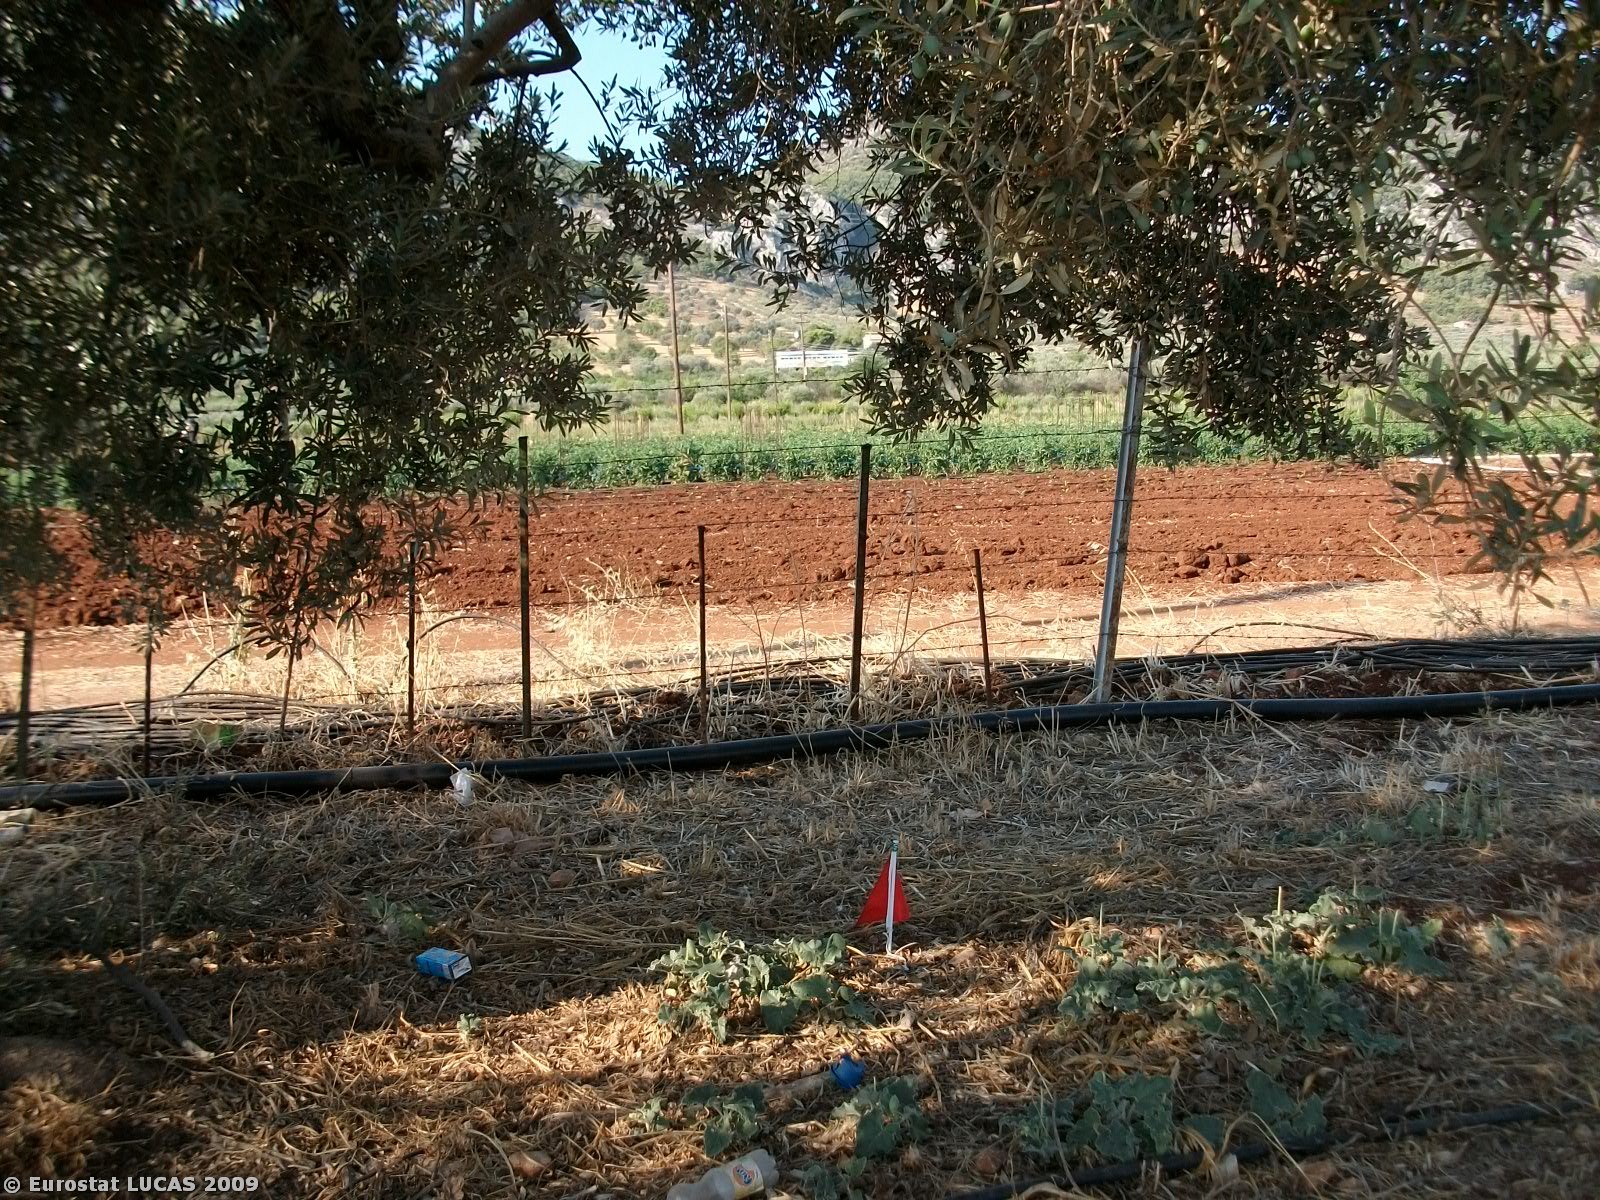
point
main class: Cropland
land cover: Olive groves
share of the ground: 50 - 75 %
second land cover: Grassland with sparse tree/shrub cover
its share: > 75 %
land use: Agriculture (excluding fallow land and kitchen gardens)
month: August
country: GR
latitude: 37.8825
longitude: 22.9674
